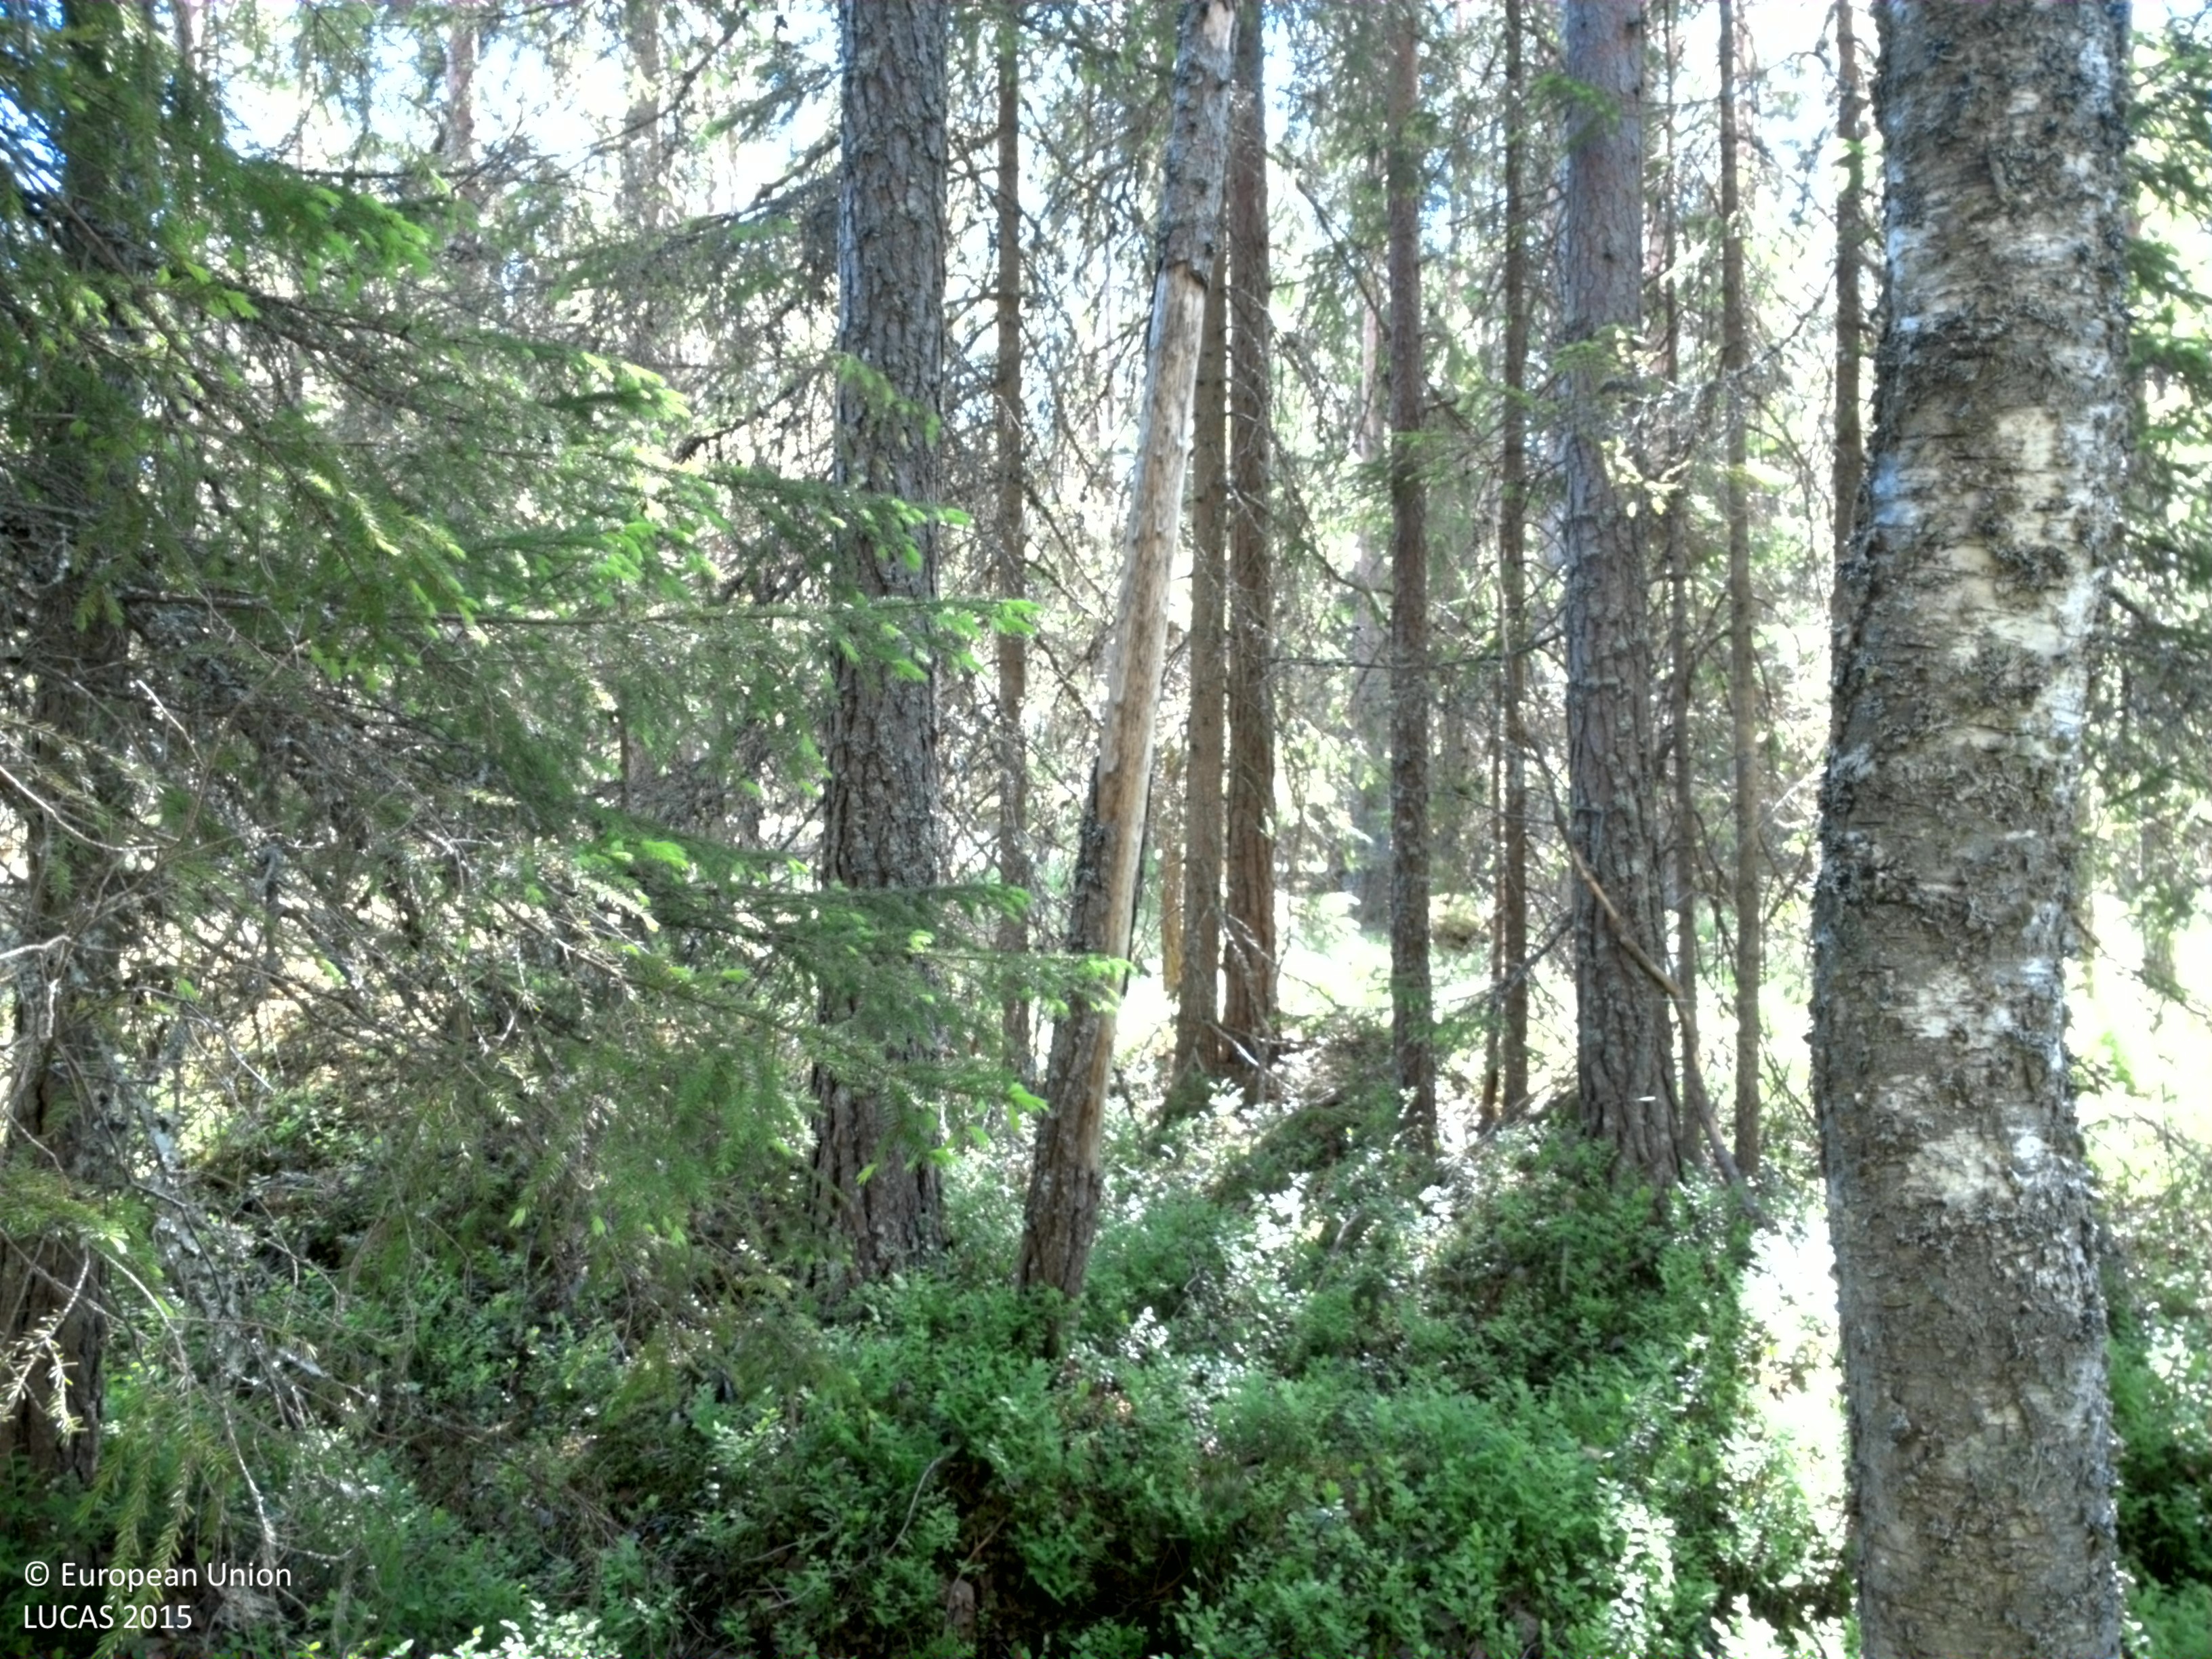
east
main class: Woodland
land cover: Other coniferous woodland
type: boreal forest
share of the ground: 50 - 75 %
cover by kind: coniferous forest trees 60 %, herbaceous plants 30 %, broadleaved forest trees 10 %
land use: Amenities, museums, leisure
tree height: > 5 m
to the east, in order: Other coniferous woodland; Pine dominated mixed woodland; Pine dominated coniferous woodland; Ditches and canals; Grass margins; Paved roads, cycling and walking lanes; Grass margins; Single bushes/trees; Broadleaved woodland
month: June
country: SE
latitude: 60.2518
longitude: 17.1639
